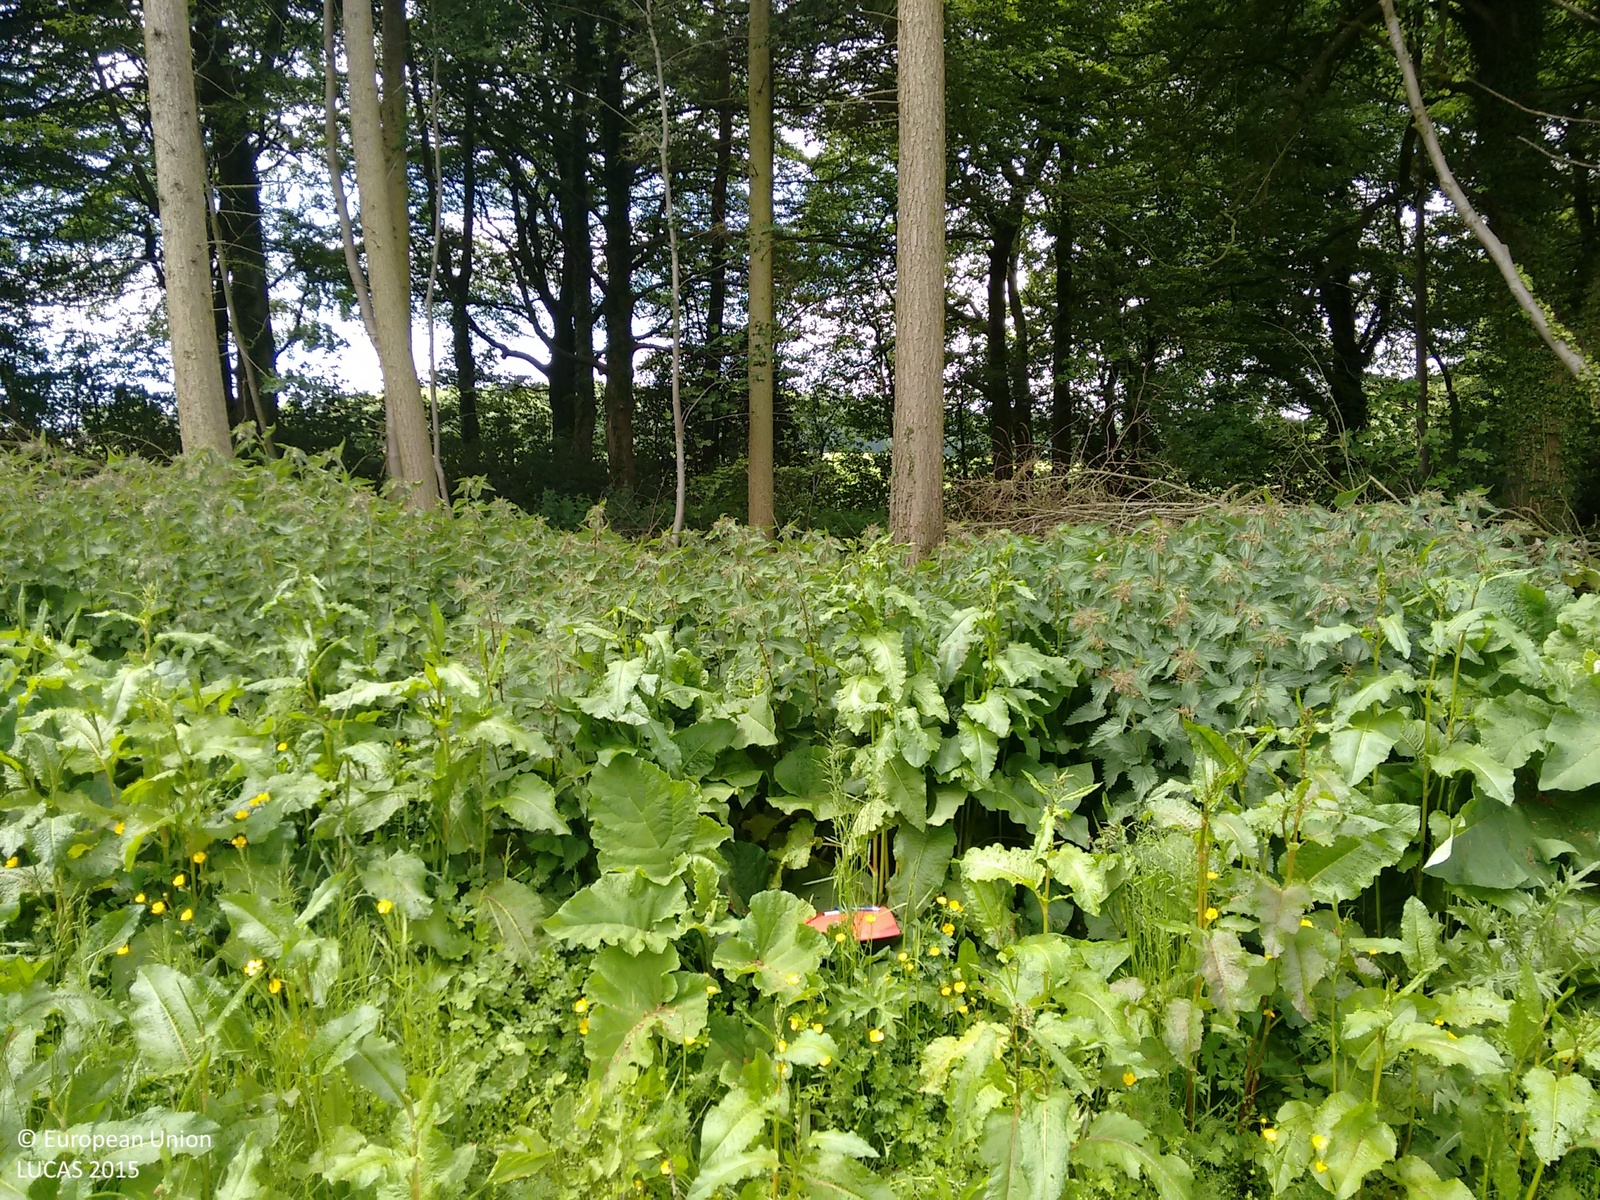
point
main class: Woodland
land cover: Broadleaved woodland
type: mesophytic deciduous forest
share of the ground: > 75 %
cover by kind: broadleaved forest trees 80 %, coniferous forest trees 20 %
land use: Semi-natural and natural areas not in use
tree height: > 5 m
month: June
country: GB
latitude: 51.0628
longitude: -2.1175
